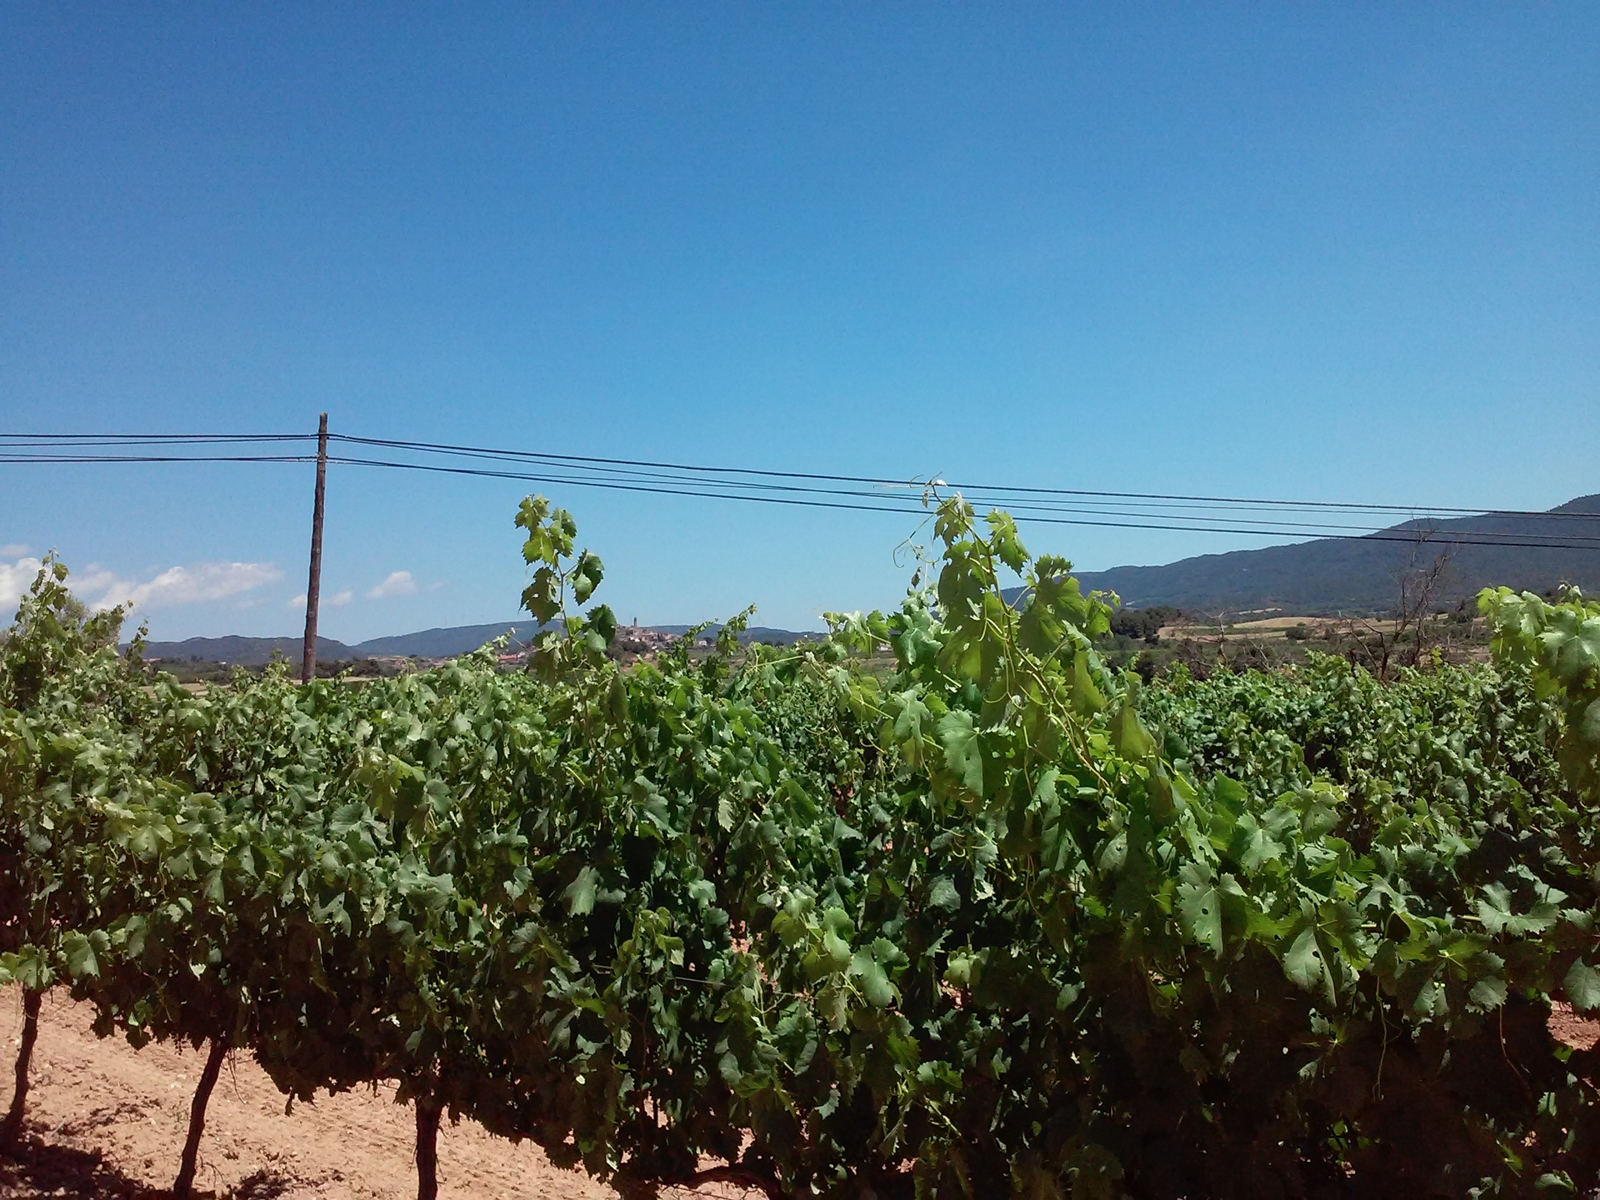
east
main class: Cropland
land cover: Vineyards
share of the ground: 25 - 50 %
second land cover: Other bare soil
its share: > 75 %
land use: Agriculture (excluding fallow land and kitchen gardens)
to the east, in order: Vineyards; Other bare soil; Electric lines; Single bushes/trees; Other bare soil; Shrubland with sparse tree cover; Paved roads, cycling and walking lanes; Shrubland with sparse tree cover; Tracks; Grass margins; Barley; Grass margins; Barley; Grass margins; Barley; Shrubland with sparse tree cover; Inland fresh running water; Shrubland with sparse tree cover
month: June
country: ES
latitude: 41.4165
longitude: 1.1979
